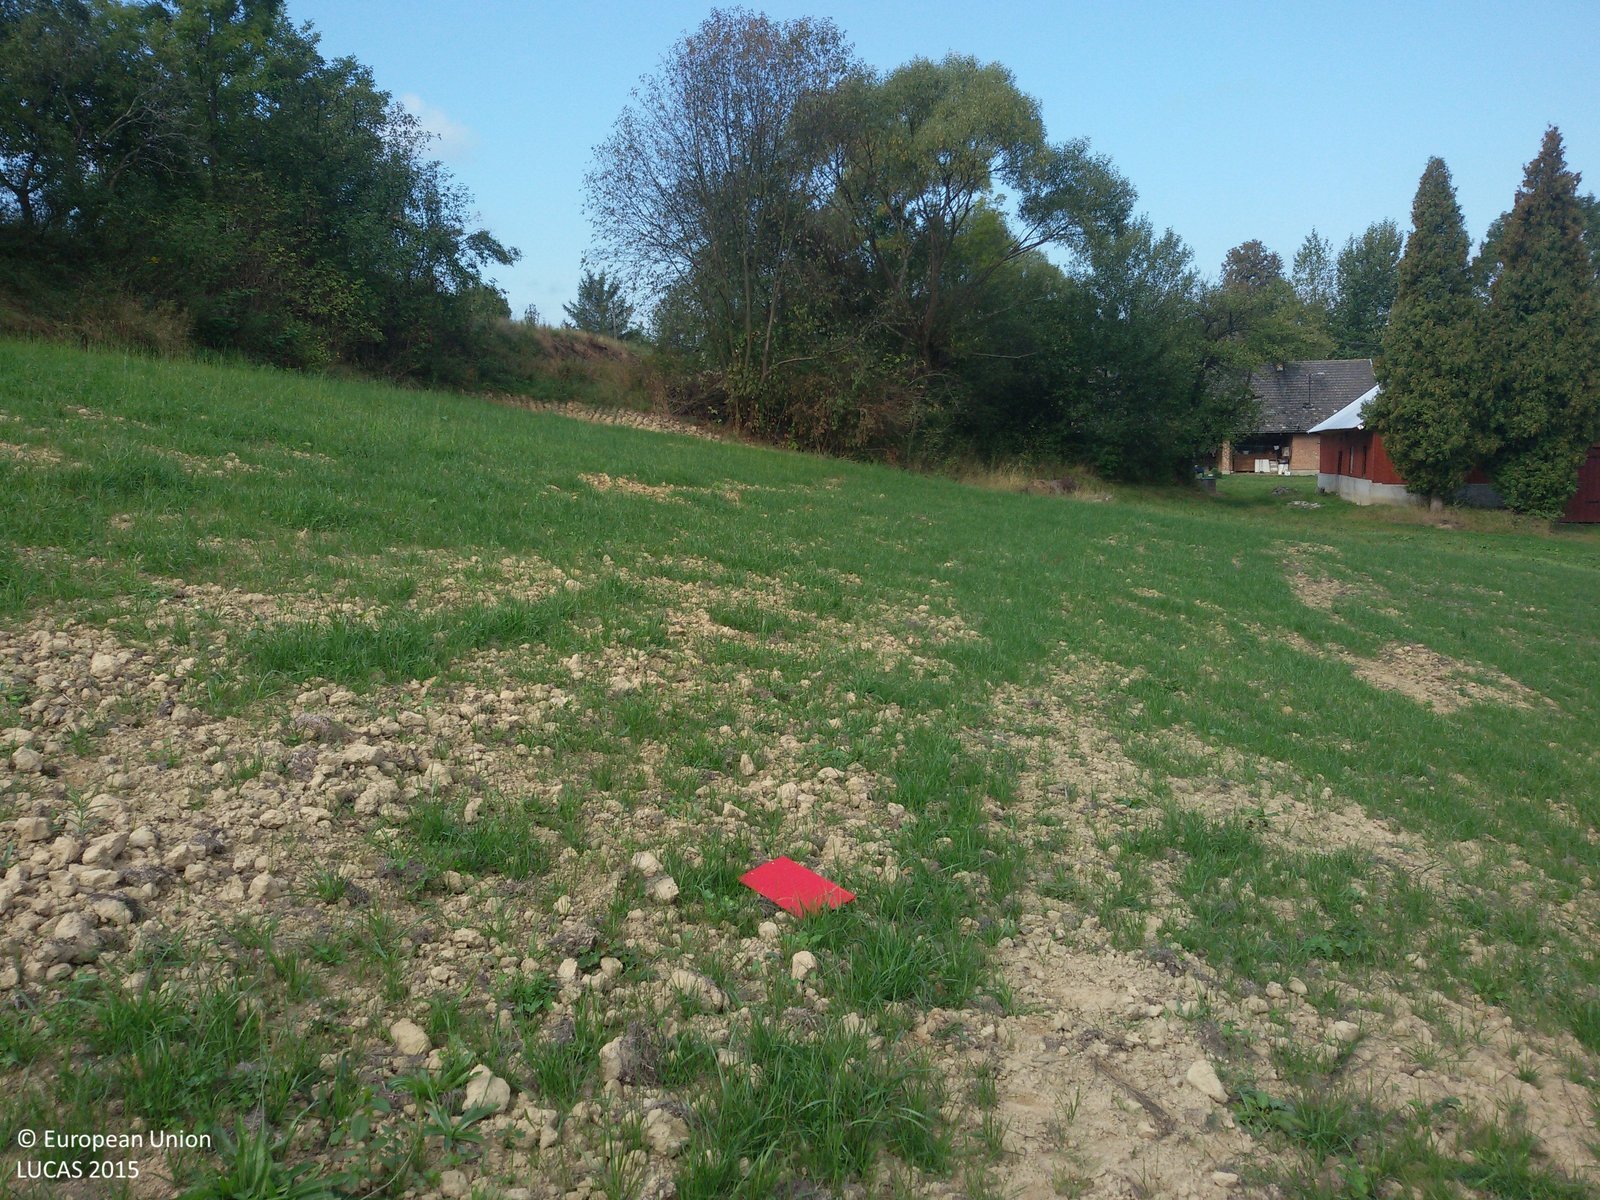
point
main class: Cropland
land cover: Rye
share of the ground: 50 - 75 %
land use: Agriculture (excluding fallow land and kitchen gardens)
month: September
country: PL
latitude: 49.7556
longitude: 21.2200
